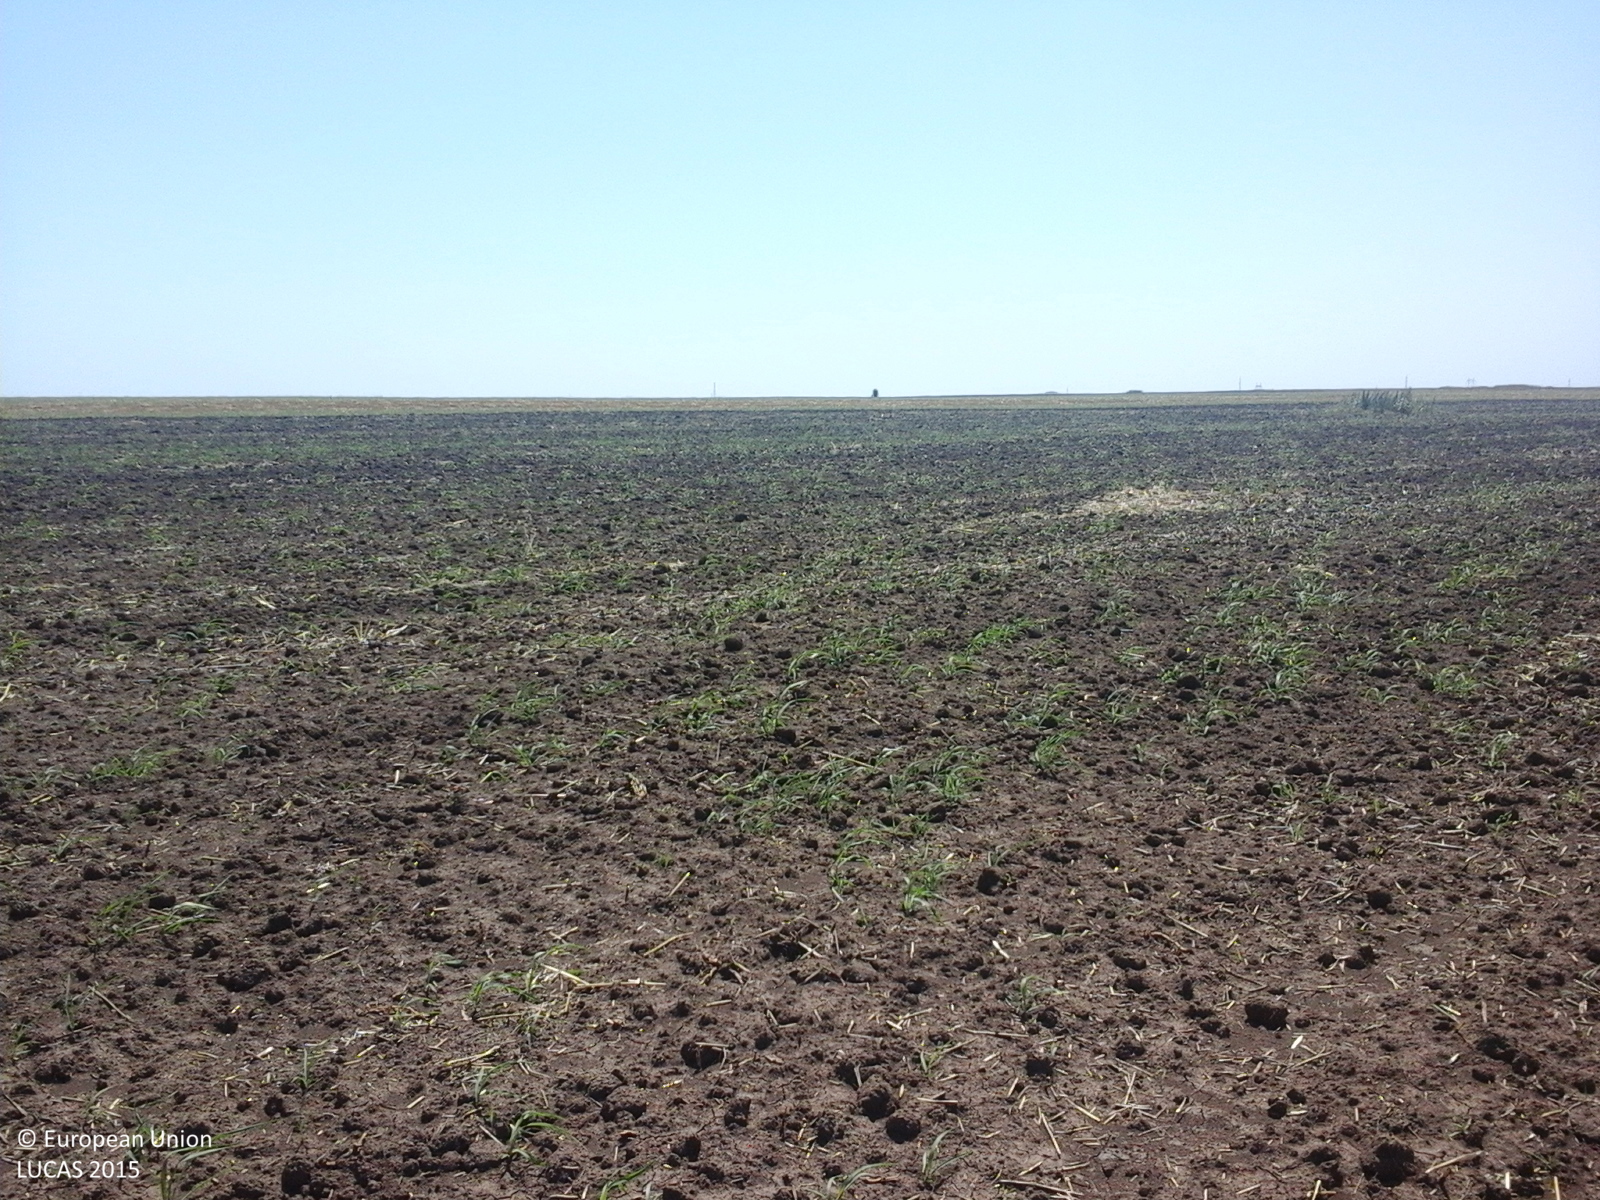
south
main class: Cropland
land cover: Common wheat
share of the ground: < 10 %
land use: Agriculture (excluding fallow land and kitchen gardens)
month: August
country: RO
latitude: 44.2364
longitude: 28.5138
